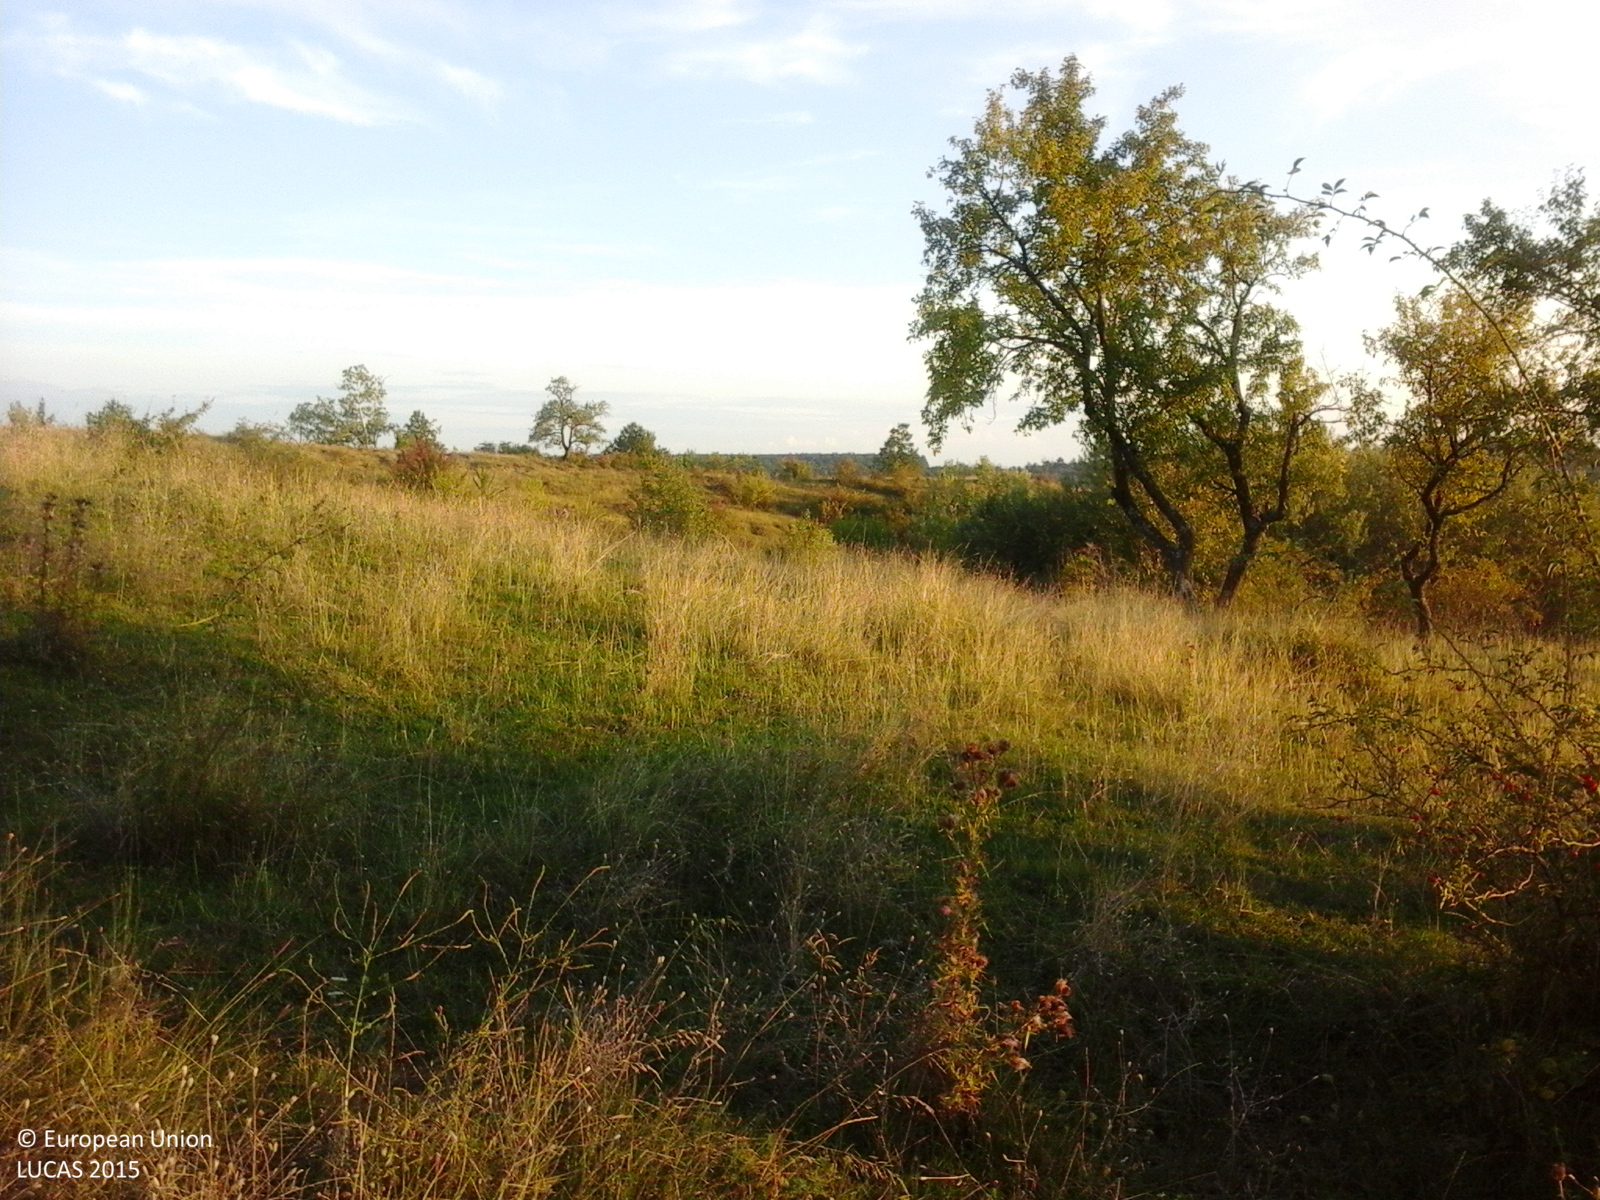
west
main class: Grassland
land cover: Grassland with sparse tree/shrub cover
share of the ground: > 75 %
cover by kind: herbaceous plants 85 %, shrubs 10 %, broadleaved forest trees 5 %
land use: Agriculture (excluding fallow land and kitchen gardens)
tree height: > 5 m
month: September
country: RO
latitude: 45.1083
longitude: 23.4923
